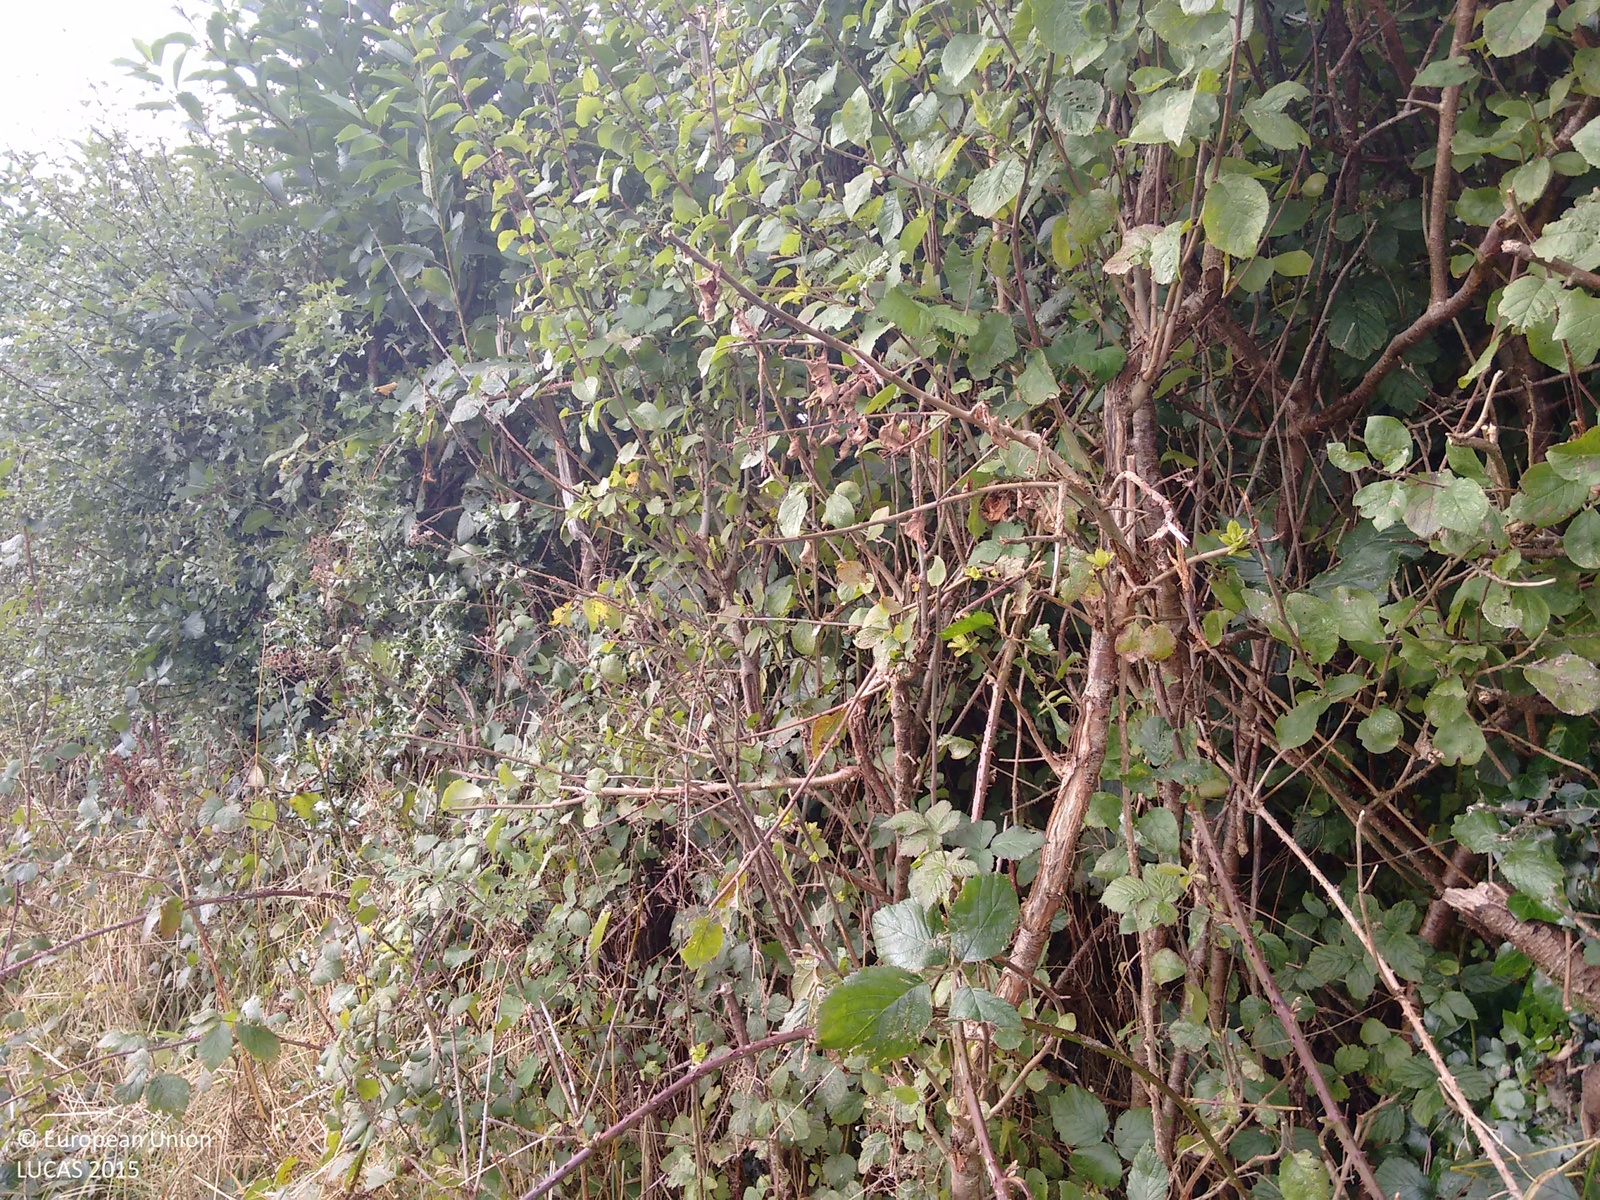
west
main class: Woodland
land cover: Broadleaved woodland
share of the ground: > 75 %
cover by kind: broadleaved forest trees 50 %, herbaceous plants 40 %, shrubs 10 %
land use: Agriculture (excluding fallow land and kitchen gardens)
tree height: < 5 m
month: September
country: IE
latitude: 53.7965
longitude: -9.1494
